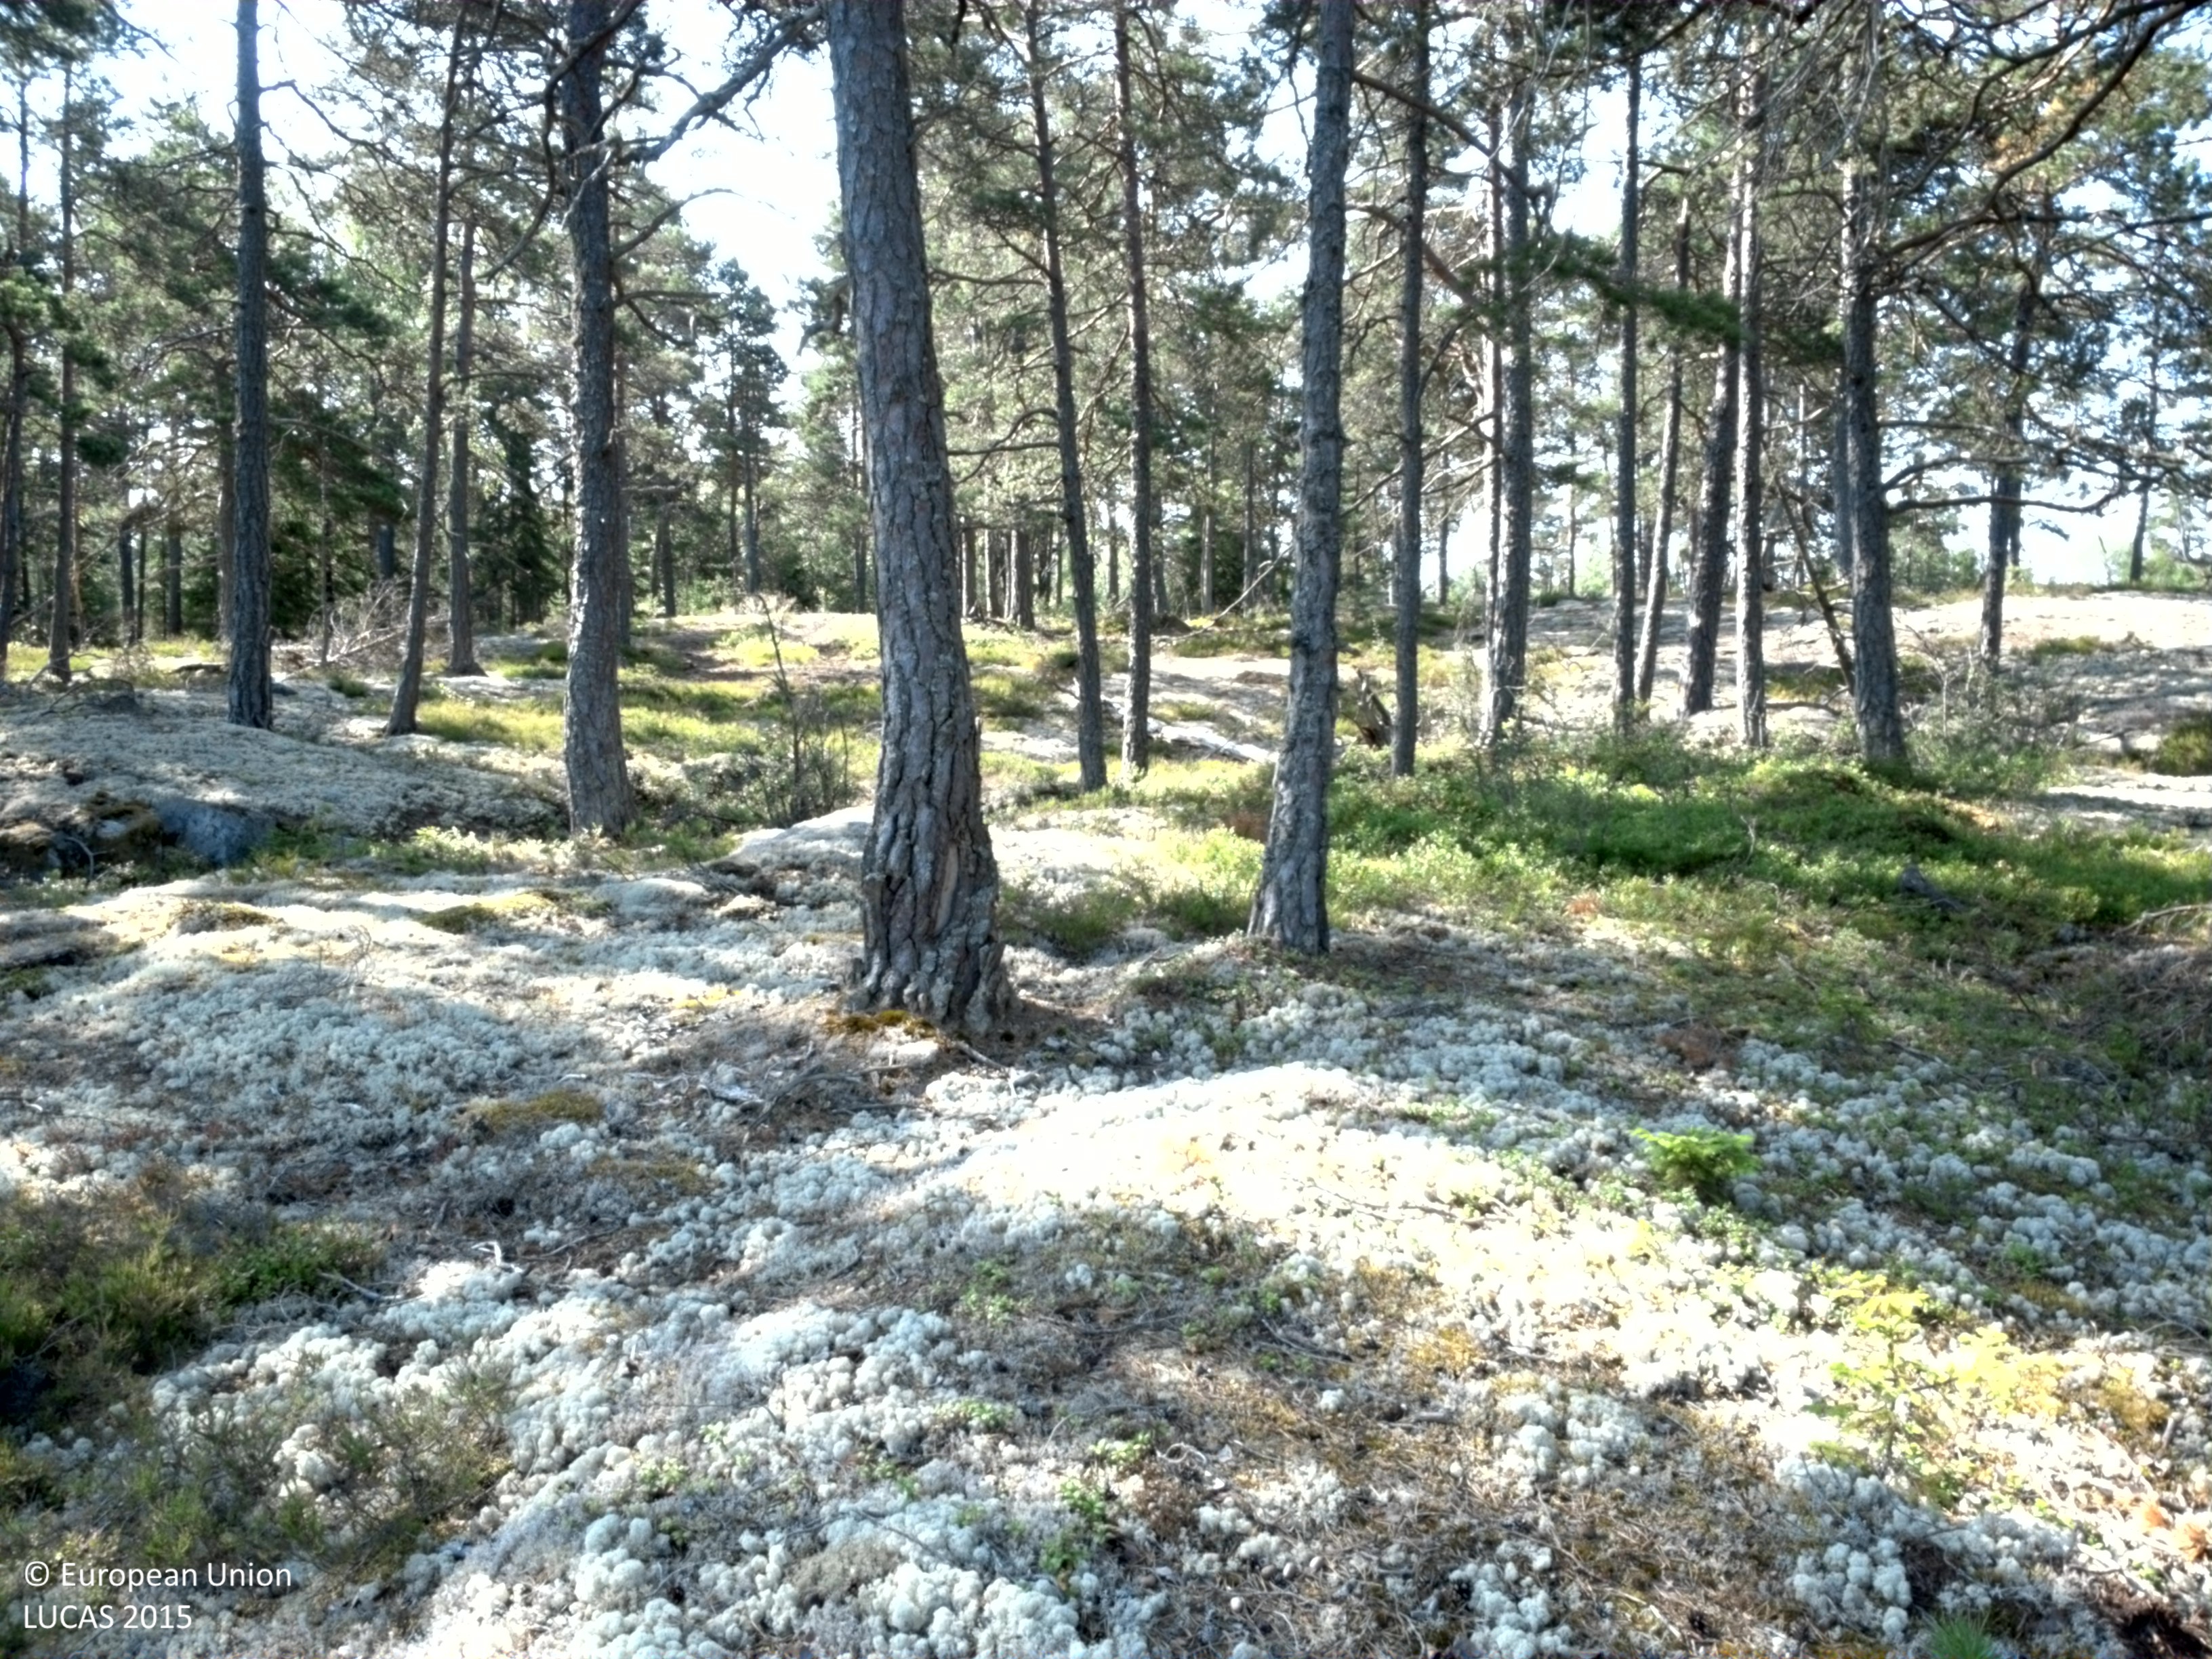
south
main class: Woodland
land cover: Pine dominated coniferous woodland
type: boreal forest
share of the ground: 25 - 50 %
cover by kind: coniferous forest trees 50 %, lichens and mosses 20 %, consolidated bare surface 20 %, shrubs 10 %
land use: Forestry
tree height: > 5 m
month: July
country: SE
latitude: 59.7058
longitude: 18.5123
